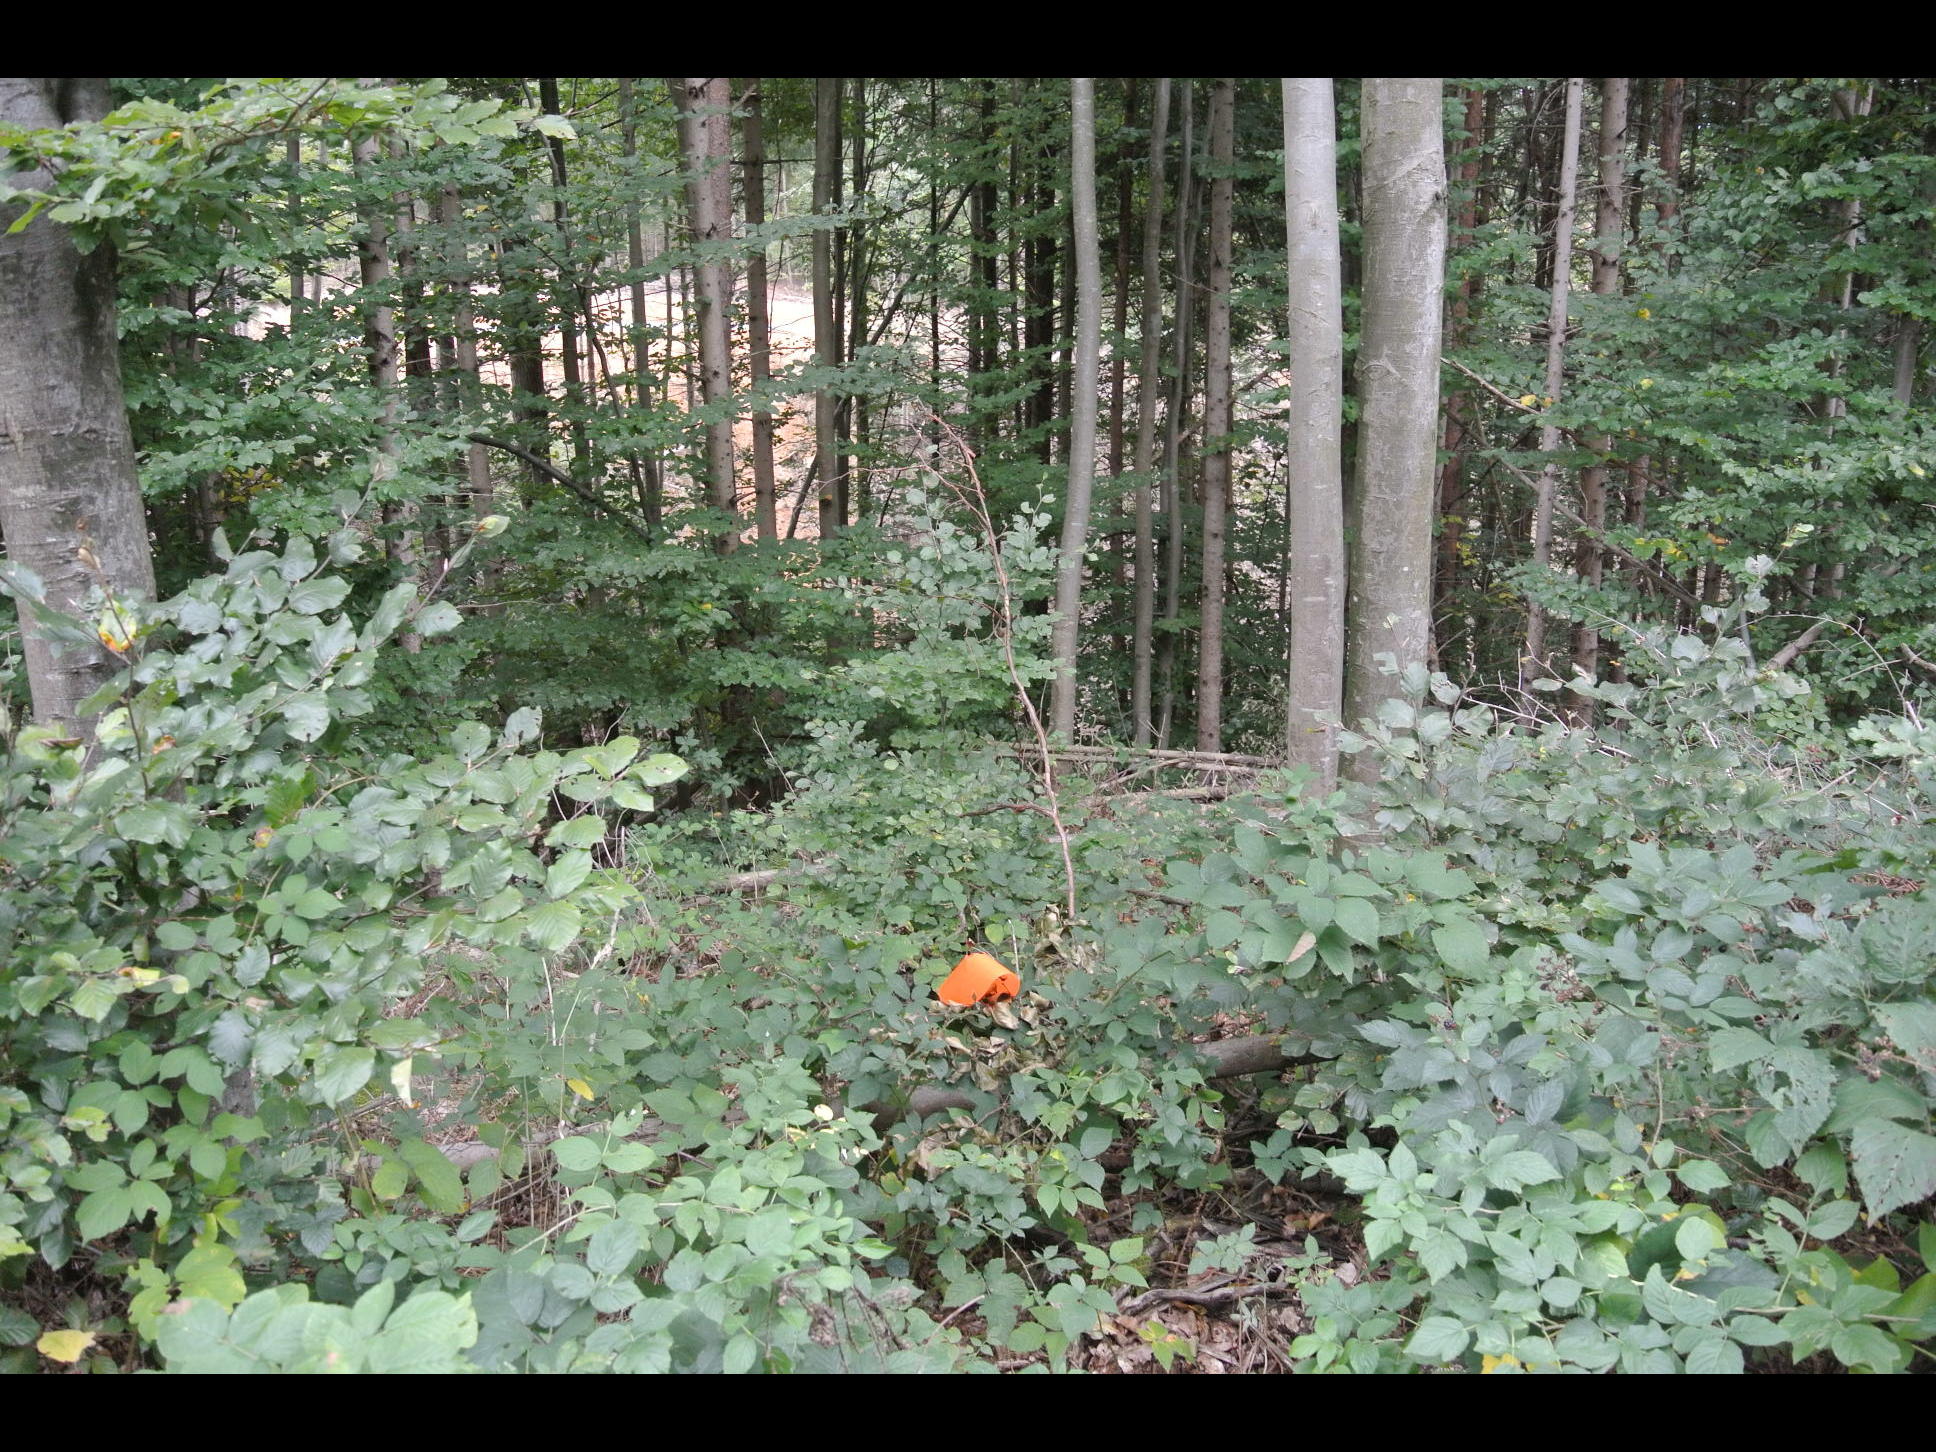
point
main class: Woodland
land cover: Spruce dominated mixed woodland
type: alpine coniferous forest
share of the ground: > 75 %
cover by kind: broadleaved forest trees 70 %, coniferous forest trees 30 %
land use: Forestry
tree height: > 5 m
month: July
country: AT
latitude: 47.4218
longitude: 16.4323
